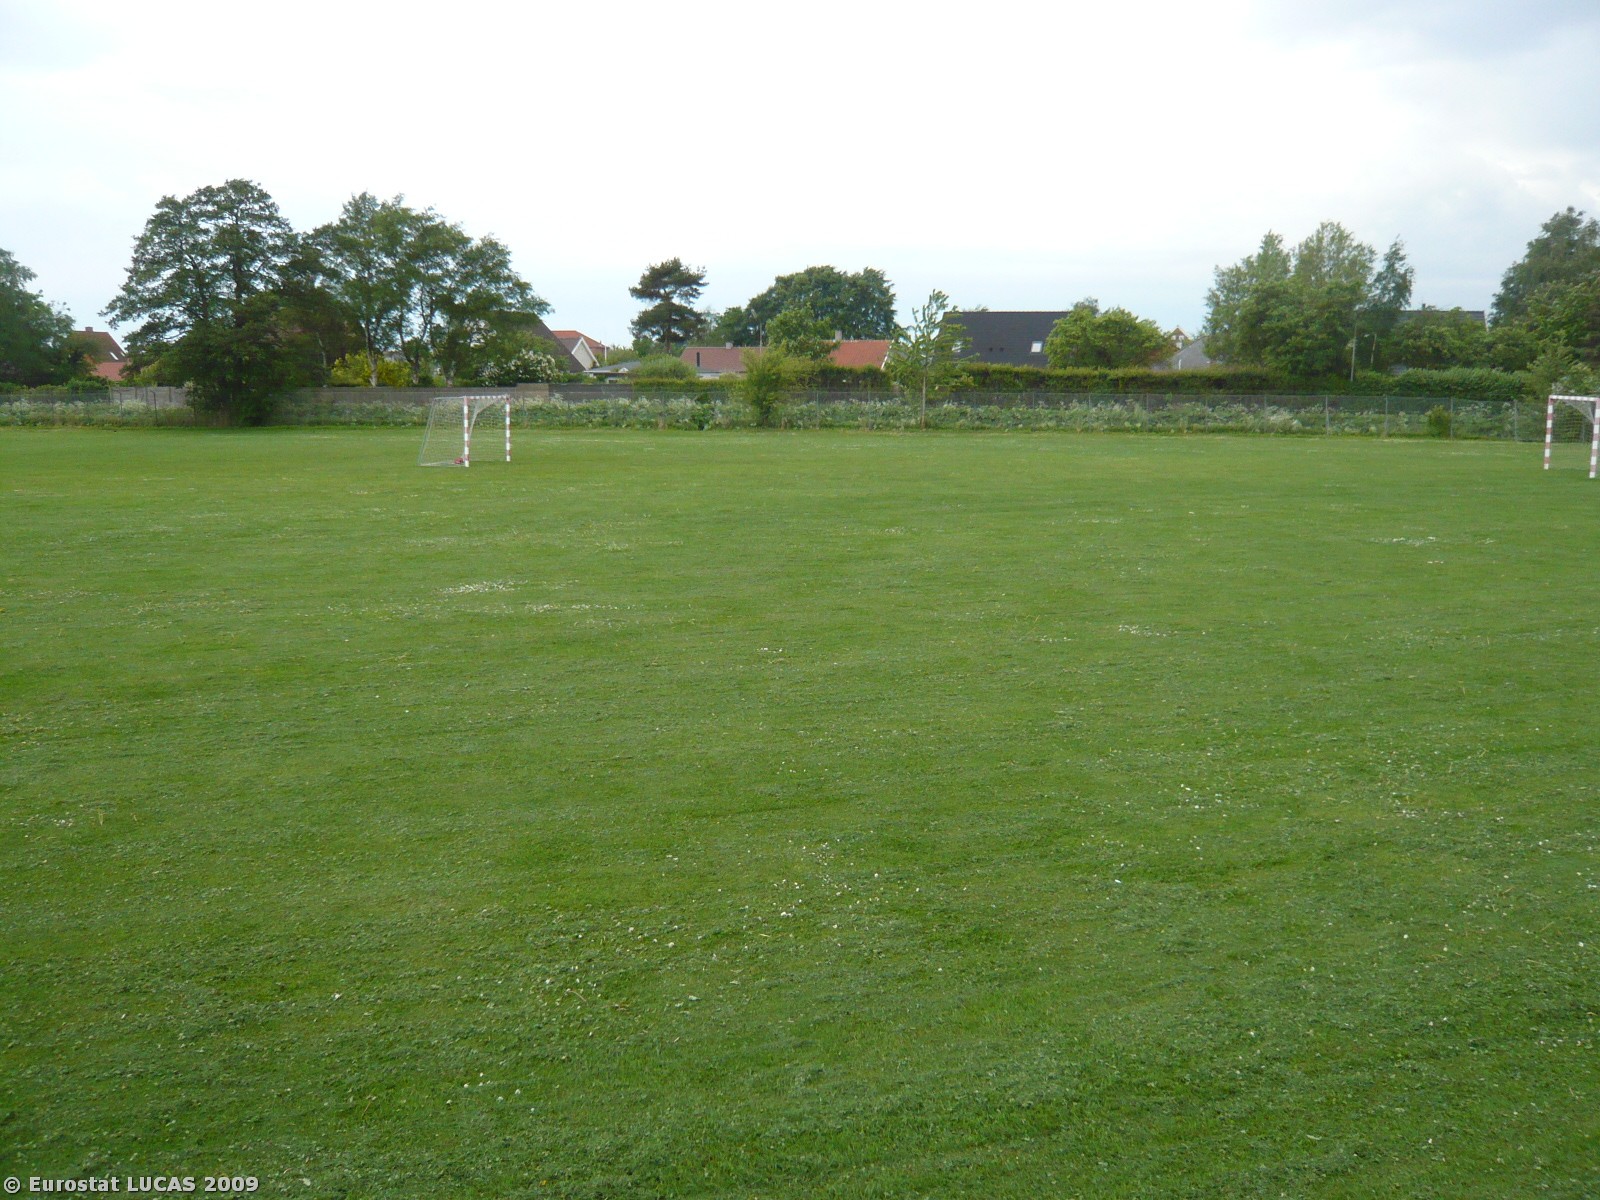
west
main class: Grassland
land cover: Grassland without tree/shrub cover
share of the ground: > 75 %
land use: Sport
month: May
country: DK
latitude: 55.2406
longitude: 11.7758
